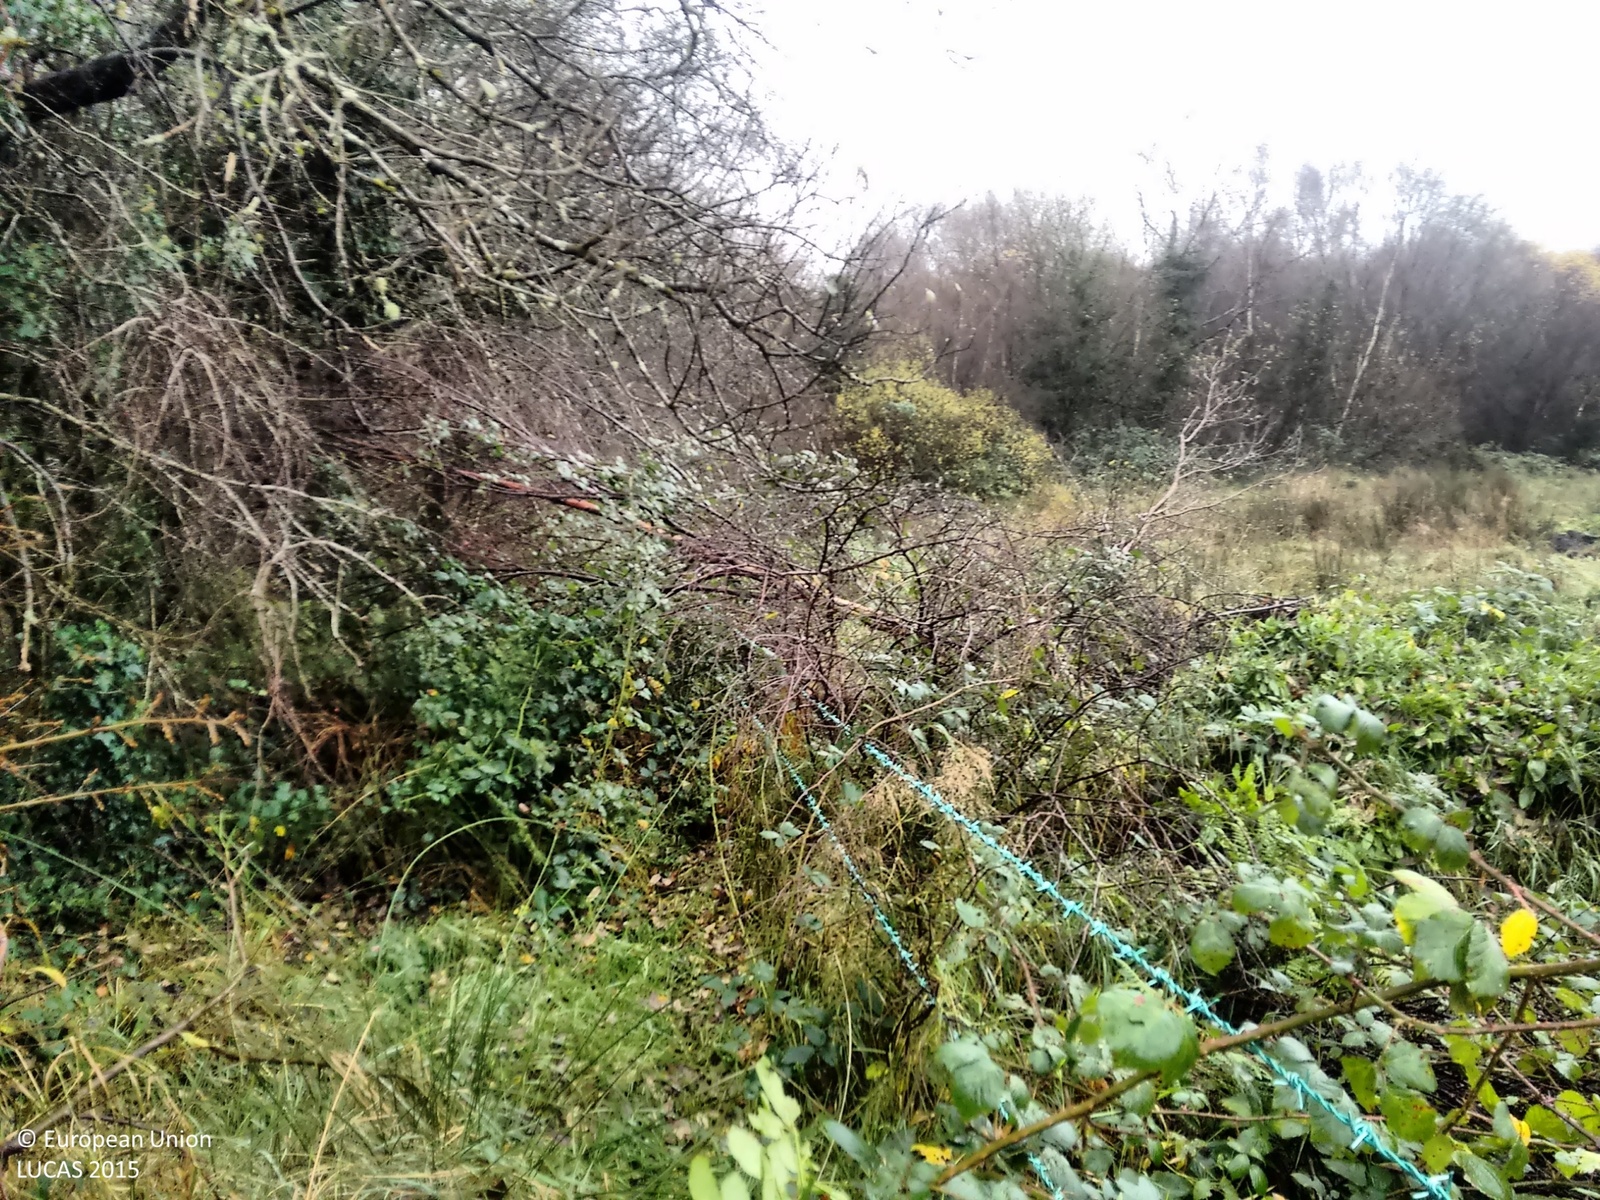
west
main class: Grassland
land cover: Spontaneously vegetated surfaces
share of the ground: > 75 %
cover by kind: herbaceous plants 95 %, shrubs 5 %
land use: Agriculture (excluding fallow land and kitchen gardens)
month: November
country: IE
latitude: 53.9361
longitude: -7.8855
